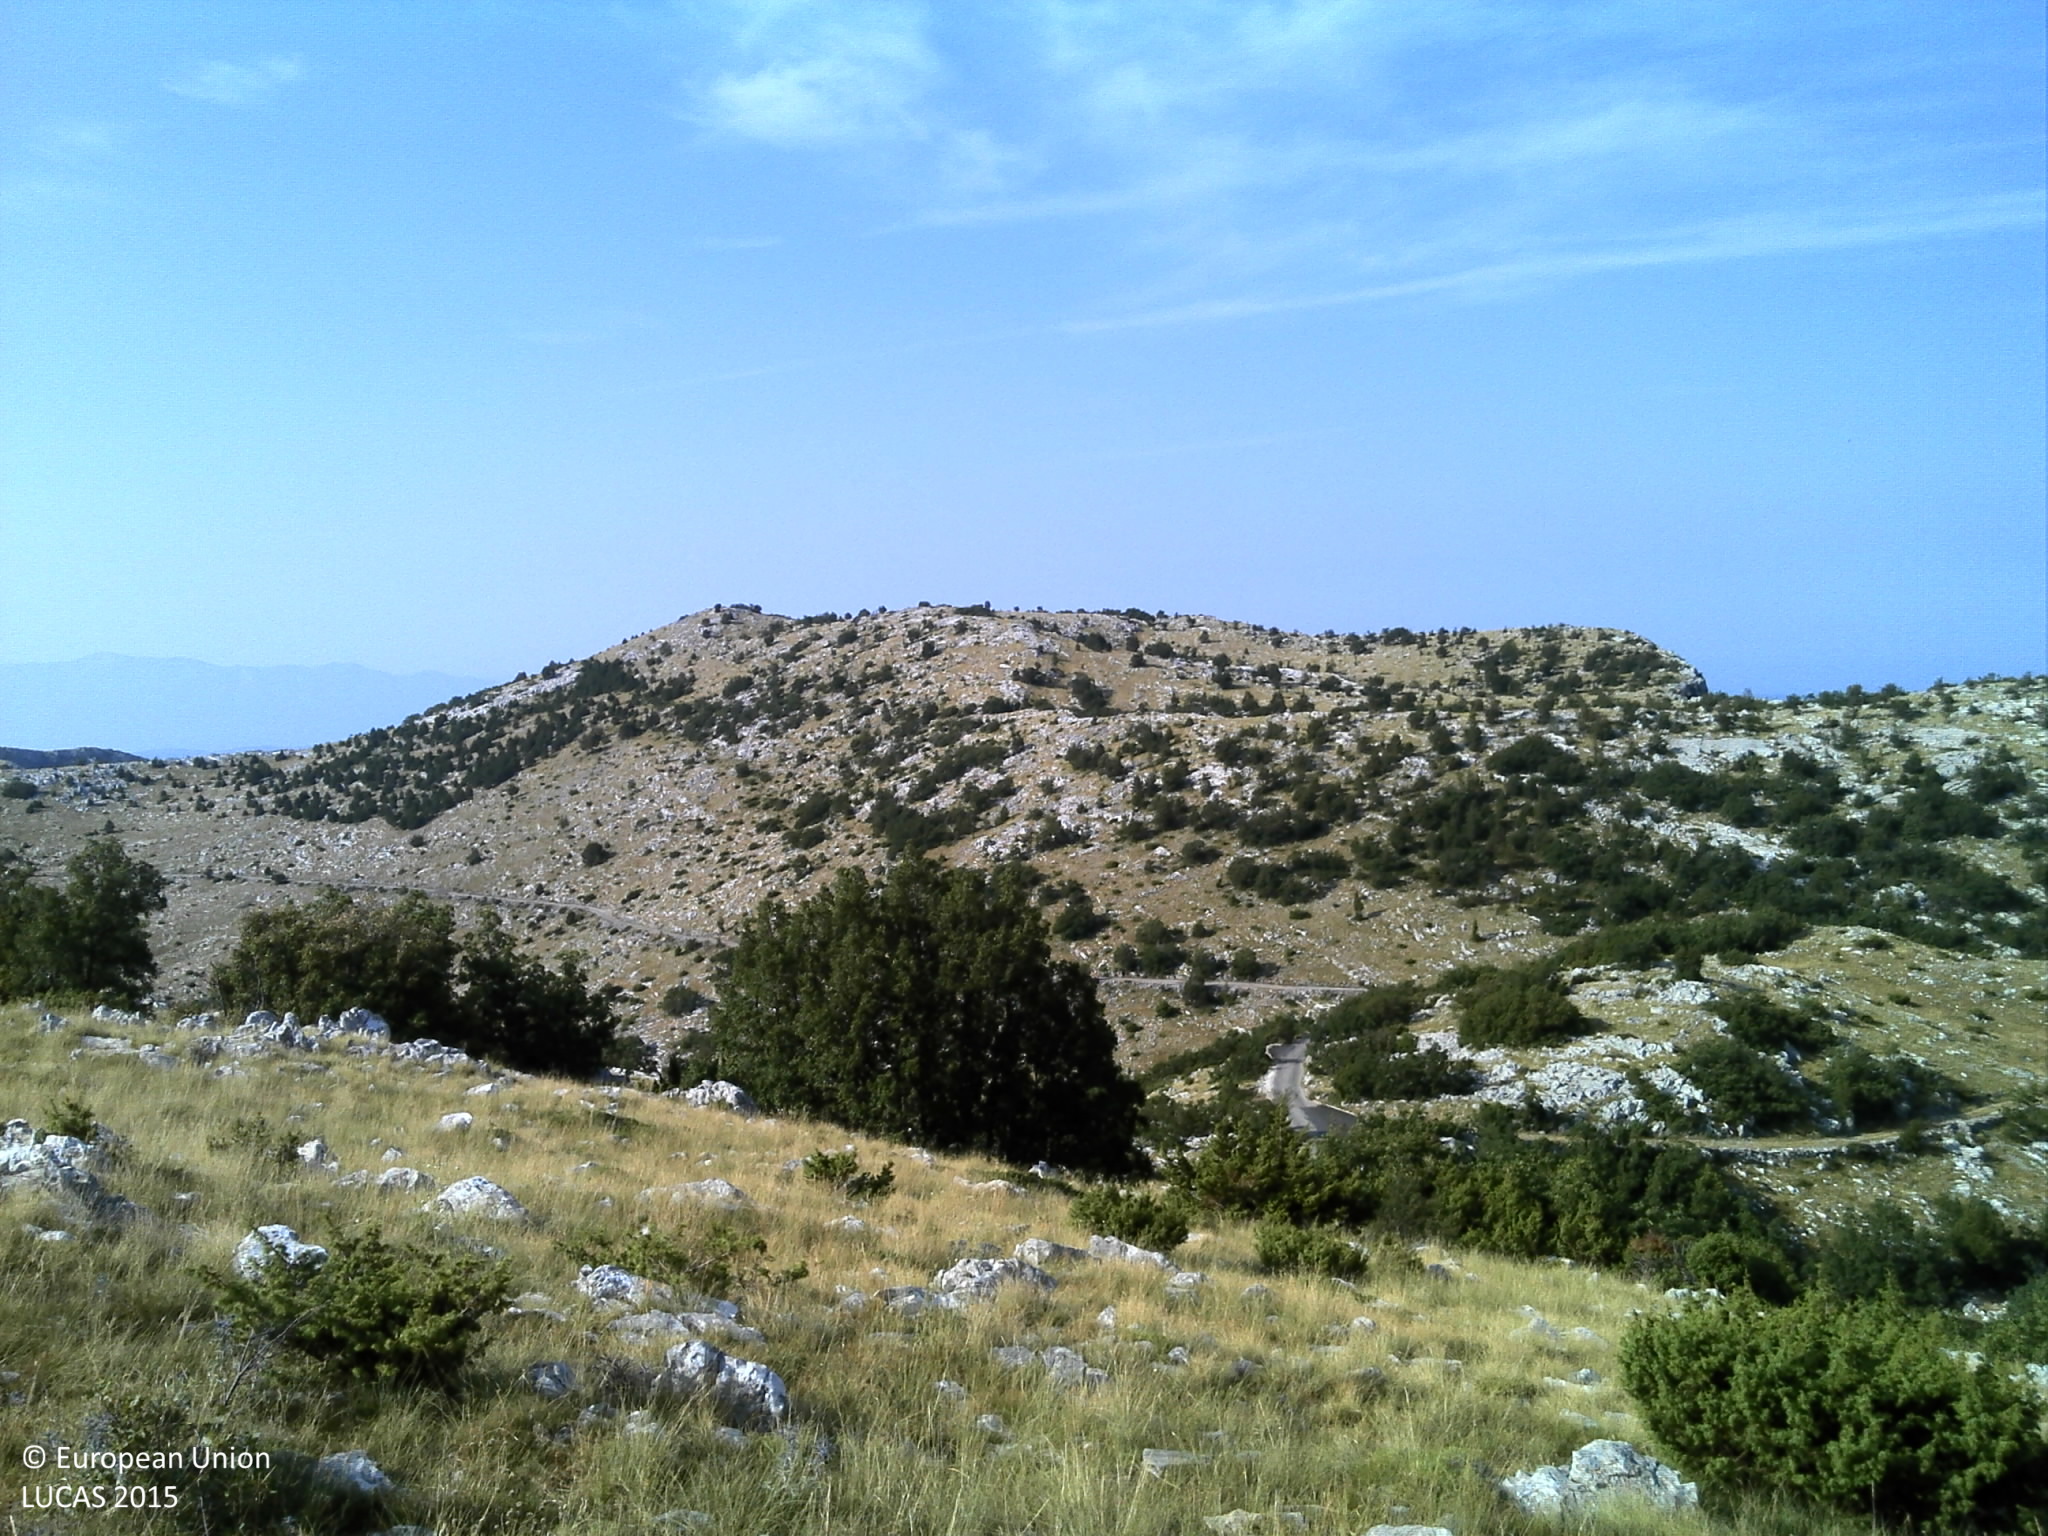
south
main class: Grassland
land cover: Grassland with sparse tree/shrub cover
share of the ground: > 75 %
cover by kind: herbaceous plants 75 %, shrubs 10 %, consolidated bare surface 10 %, broadleaved forest trees 5 %
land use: Semi-natural and natural areas not in use
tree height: < 5 m
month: August
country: HR
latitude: 43.2743
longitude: 17.1005
